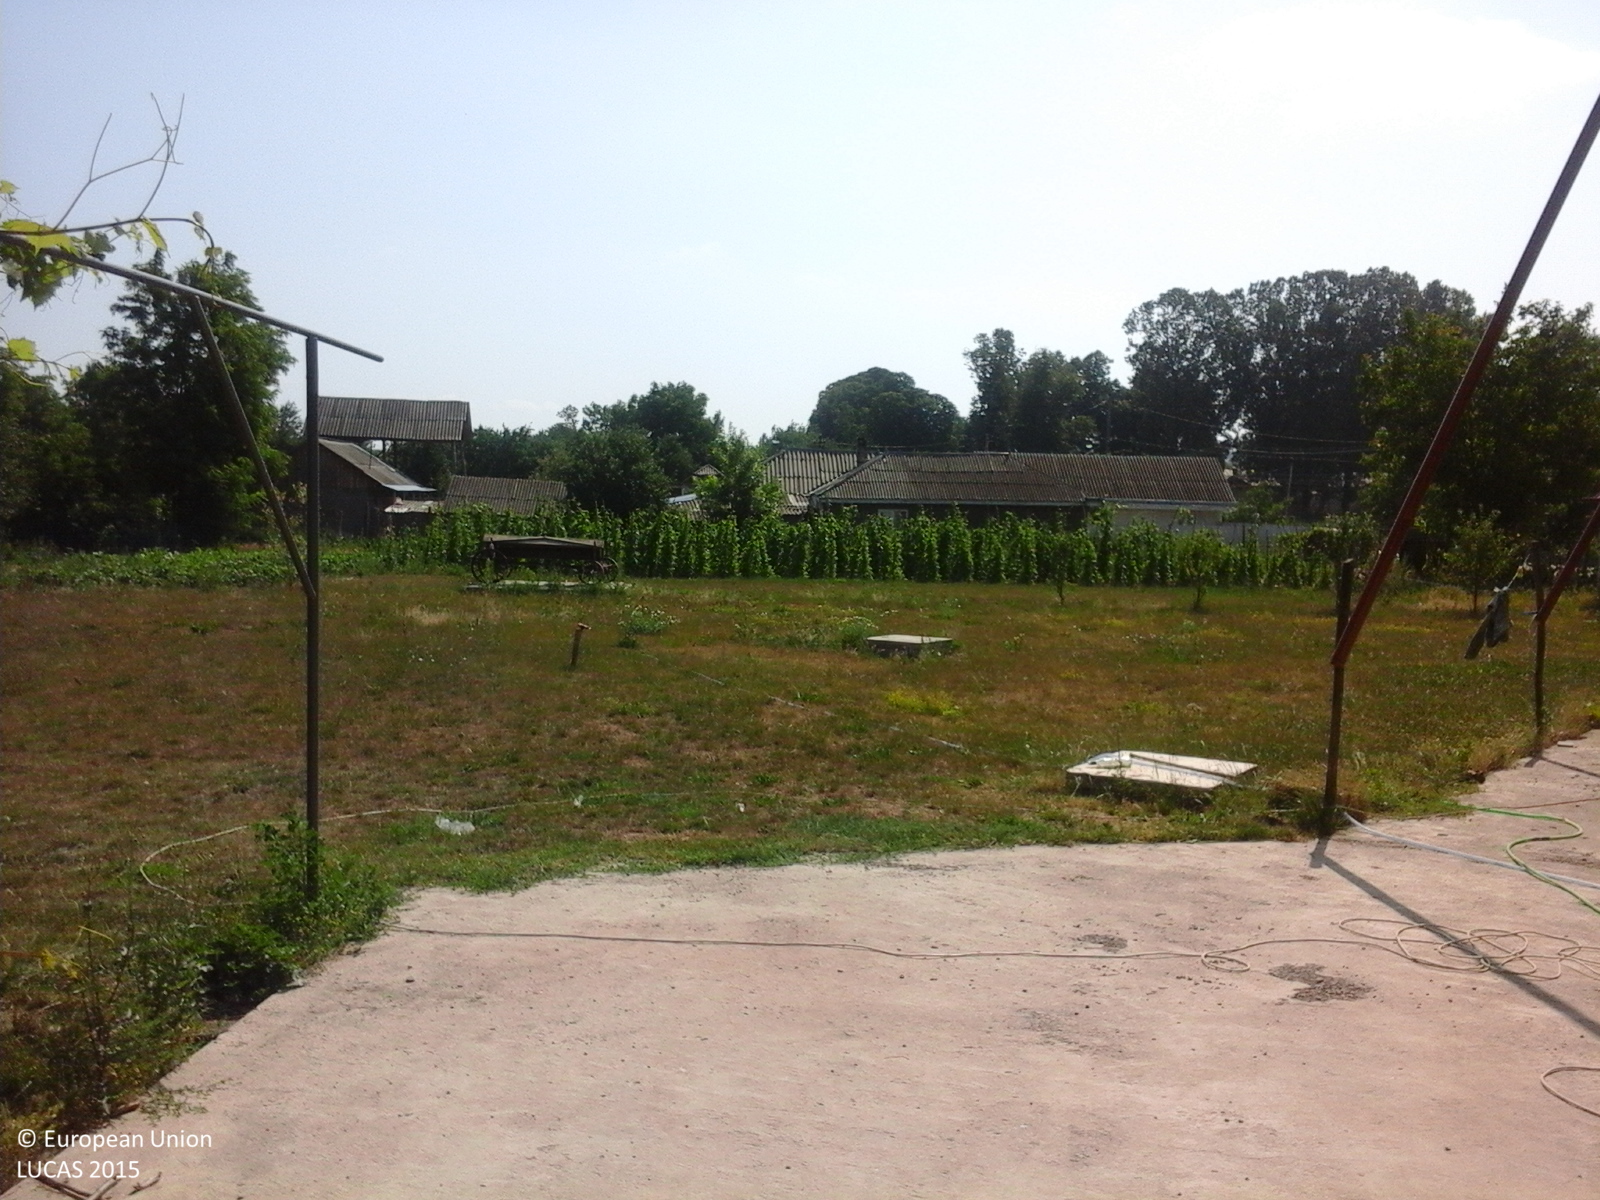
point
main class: Grassland
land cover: Grassland without tree/shrub cover
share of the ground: > 75 %
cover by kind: herbaceous plants 100 %
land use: Residential
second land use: Agriculture (excluding fallow land and kitchen gardens)
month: June
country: RO
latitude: 46.7437
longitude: 26.9952
